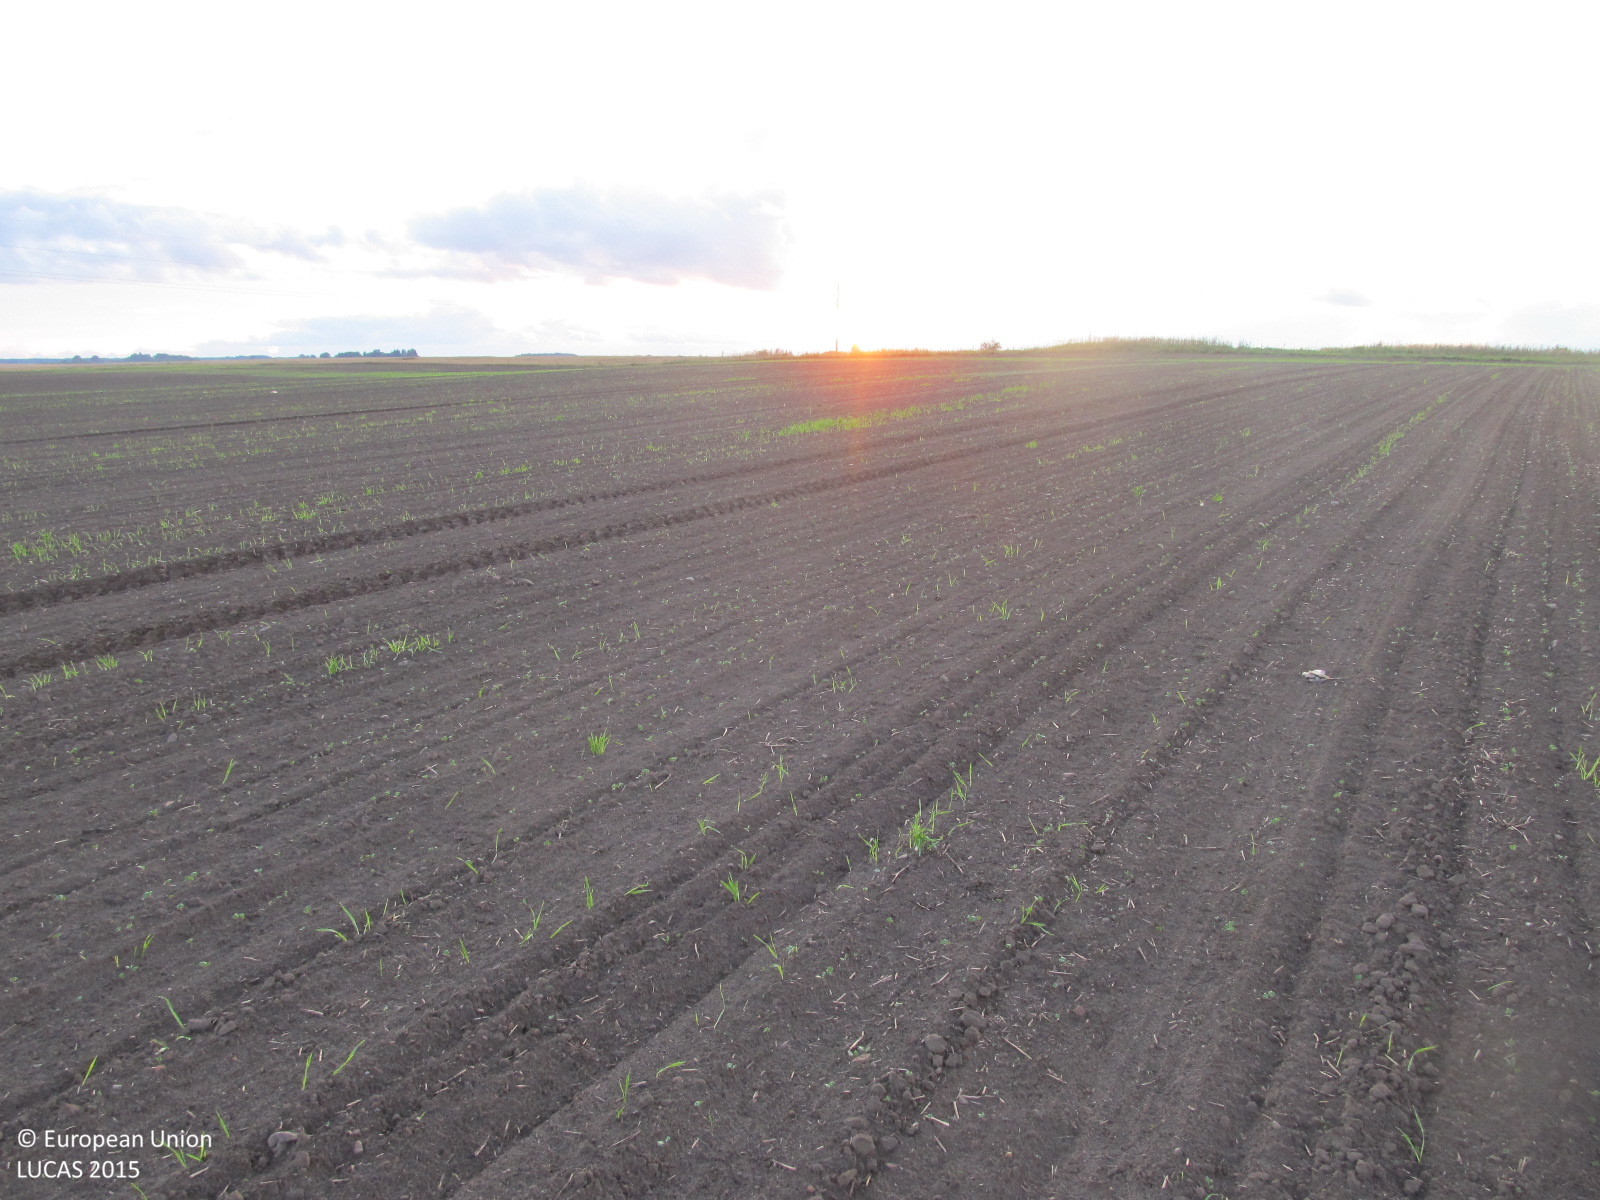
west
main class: Cropland
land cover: Rape and turnip rape
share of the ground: < 10 %
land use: Agriculture (excluding fallow land and kitchen gardens)
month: September
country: LT
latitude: 56.1628
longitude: 23.1615
